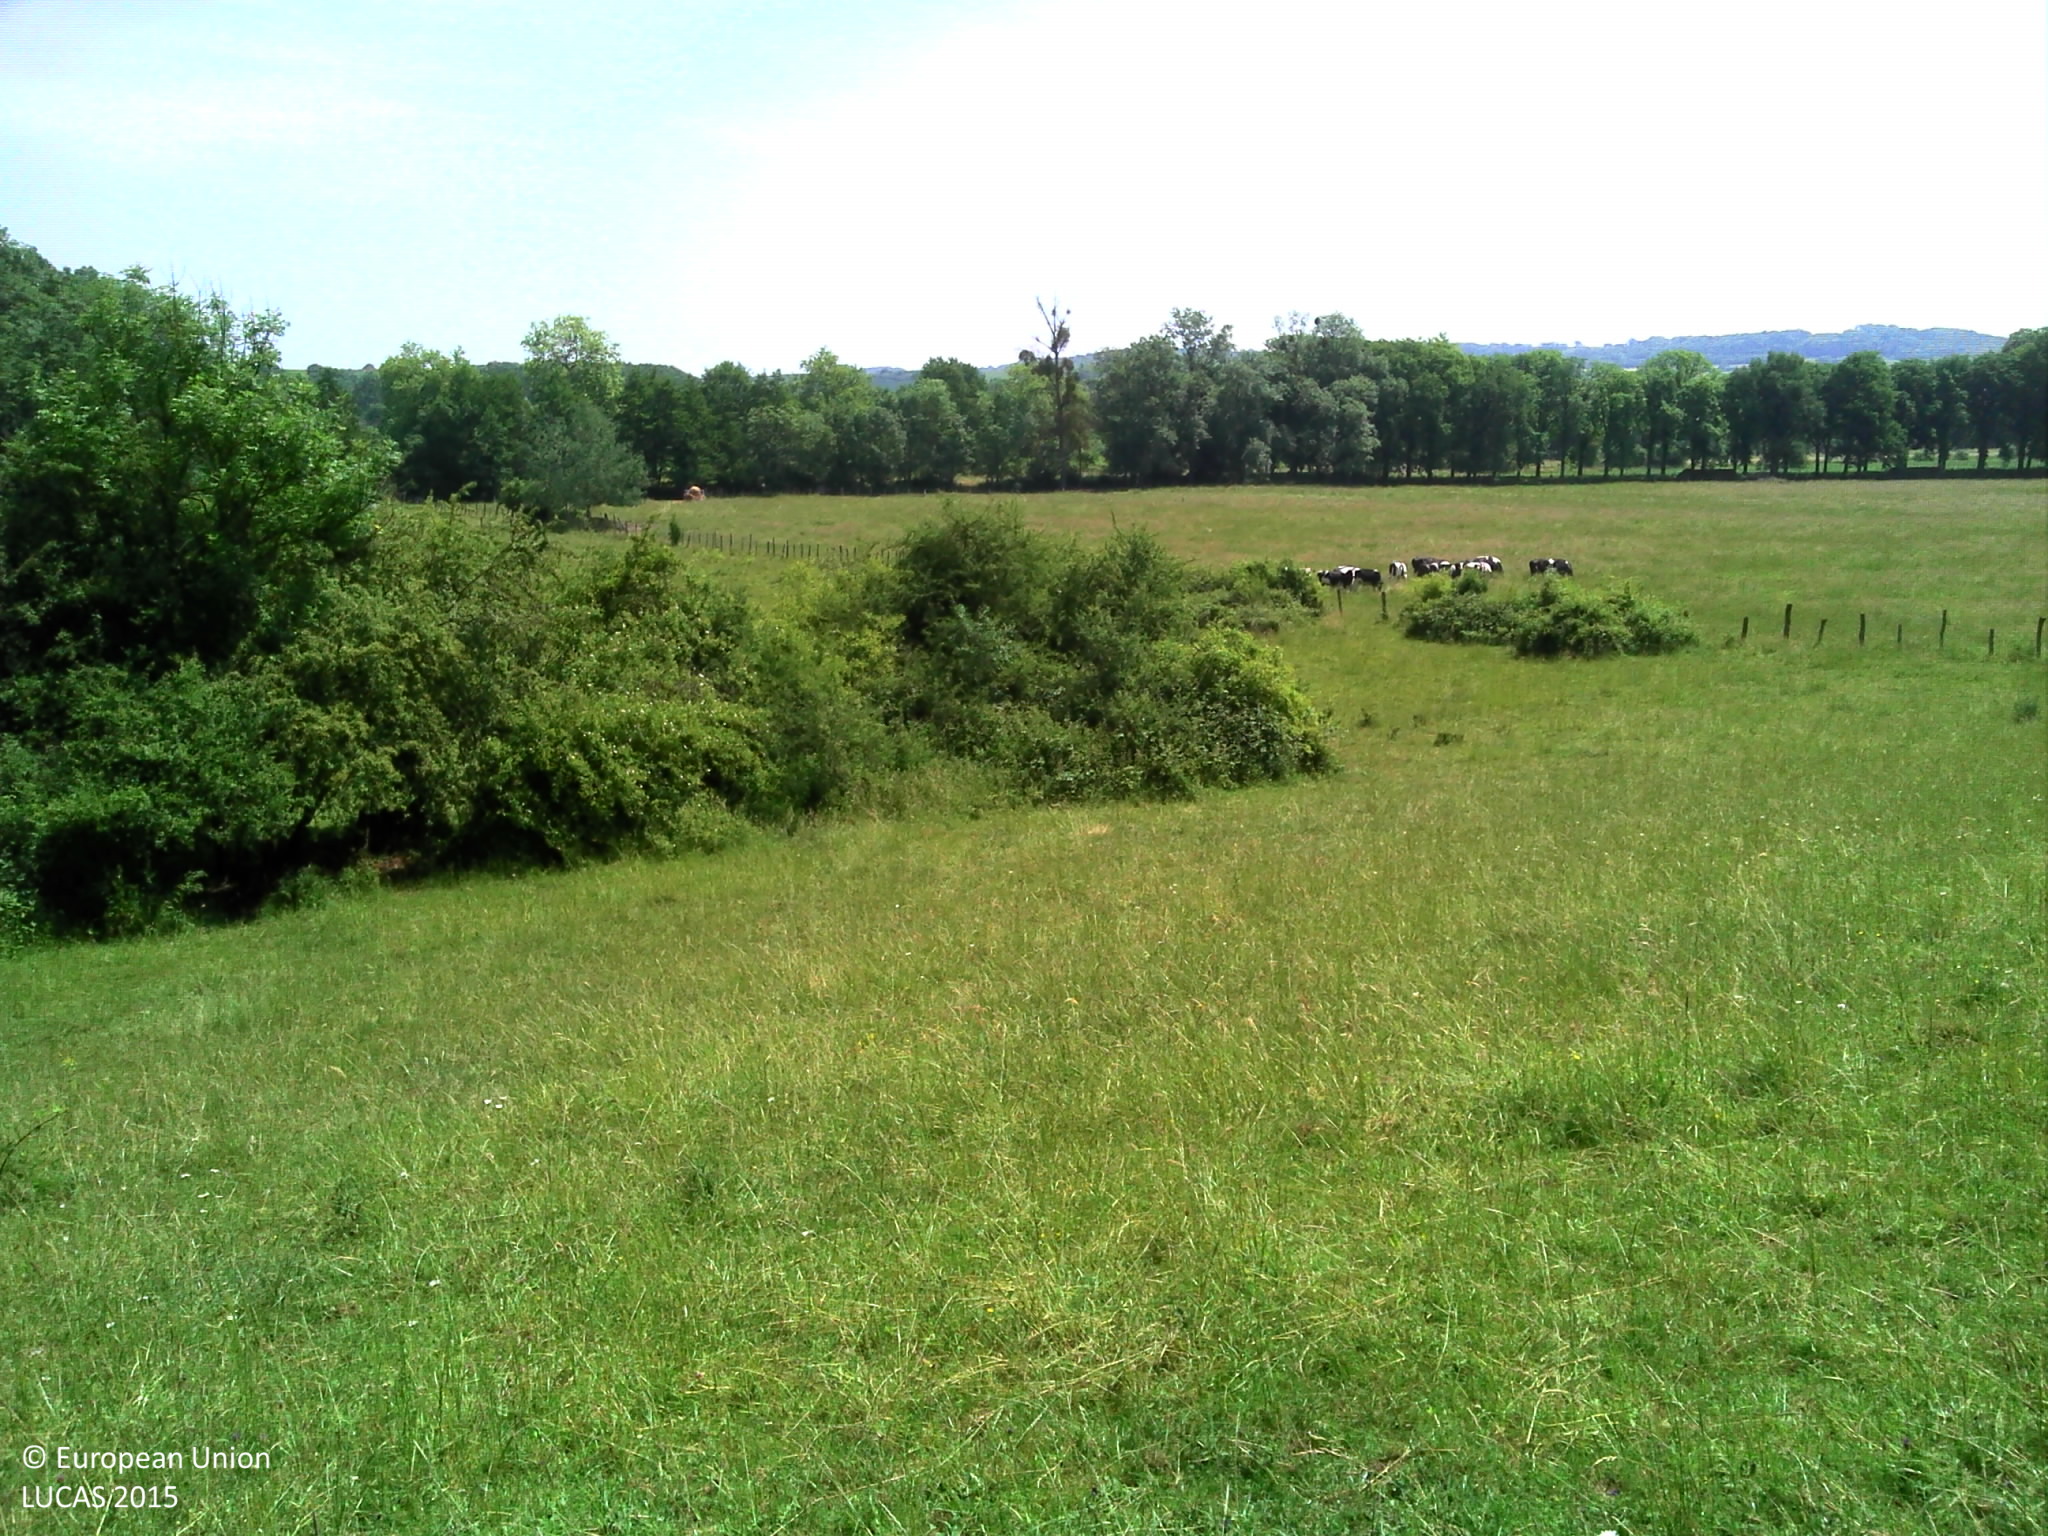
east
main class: Grassland
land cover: Grassland without tree/shrub cover
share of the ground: > 75 %
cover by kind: herbaceous plants 100 %
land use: Agriculture (excluding fallow land and kitchen gardens)
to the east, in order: Grassland without tree/shrub cover; Broadleaved woodland; Grassland without tree/shrub cover; Shrubland without tree cover; Fences; Grassland without tree/shrub cover
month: June
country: FR
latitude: 48.5030
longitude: 6.2783
